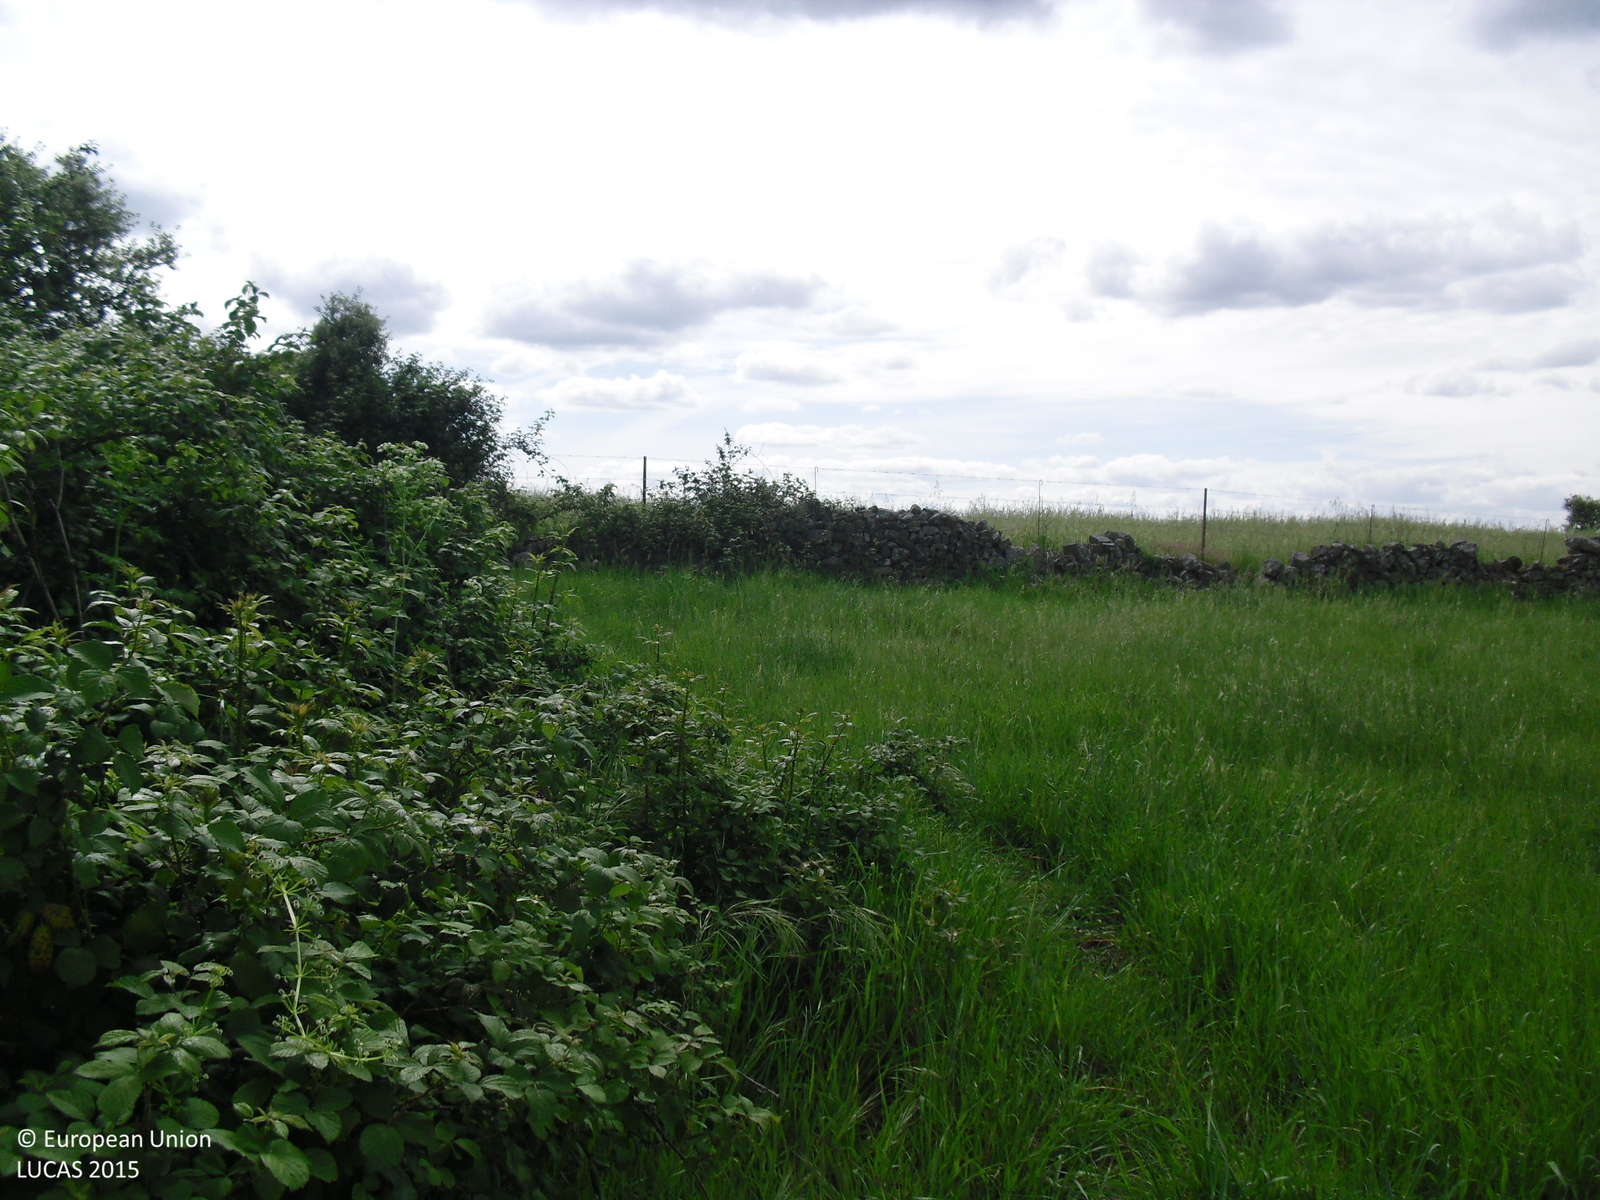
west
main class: Grassland
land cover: Grassland without tree/shrub cover
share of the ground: > 75 %
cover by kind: herbaceous plants 95 %, shrubs 5 %
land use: Agriculture (excluding fallow land and kitchen gardens)
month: April
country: ES
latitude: 39.3296
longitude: -6.0093
